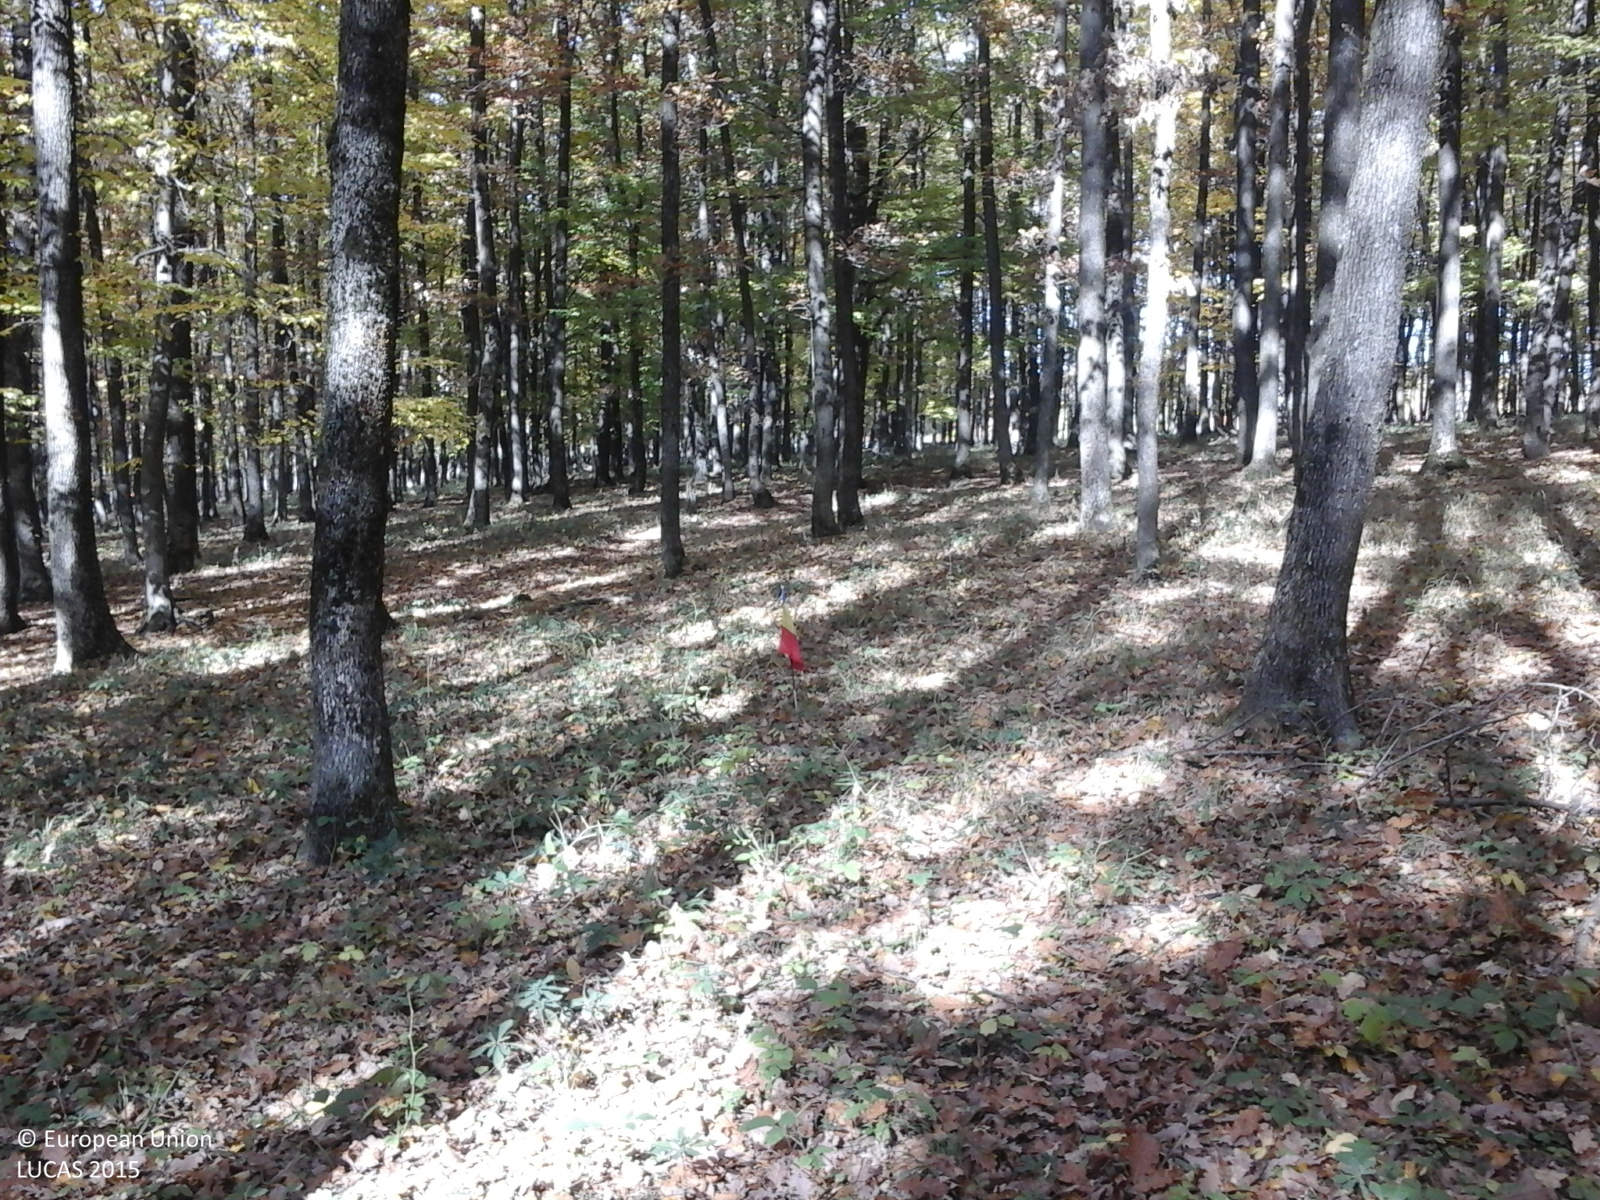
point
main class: Woodland
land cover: Broadleaved woodland
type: beech forest
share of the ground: > 75 %
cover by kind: broadleaved forest trees 100 %
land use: Forestry
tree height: > 5 m
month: October
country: RO
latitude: 46.0347
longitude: 27.0586
